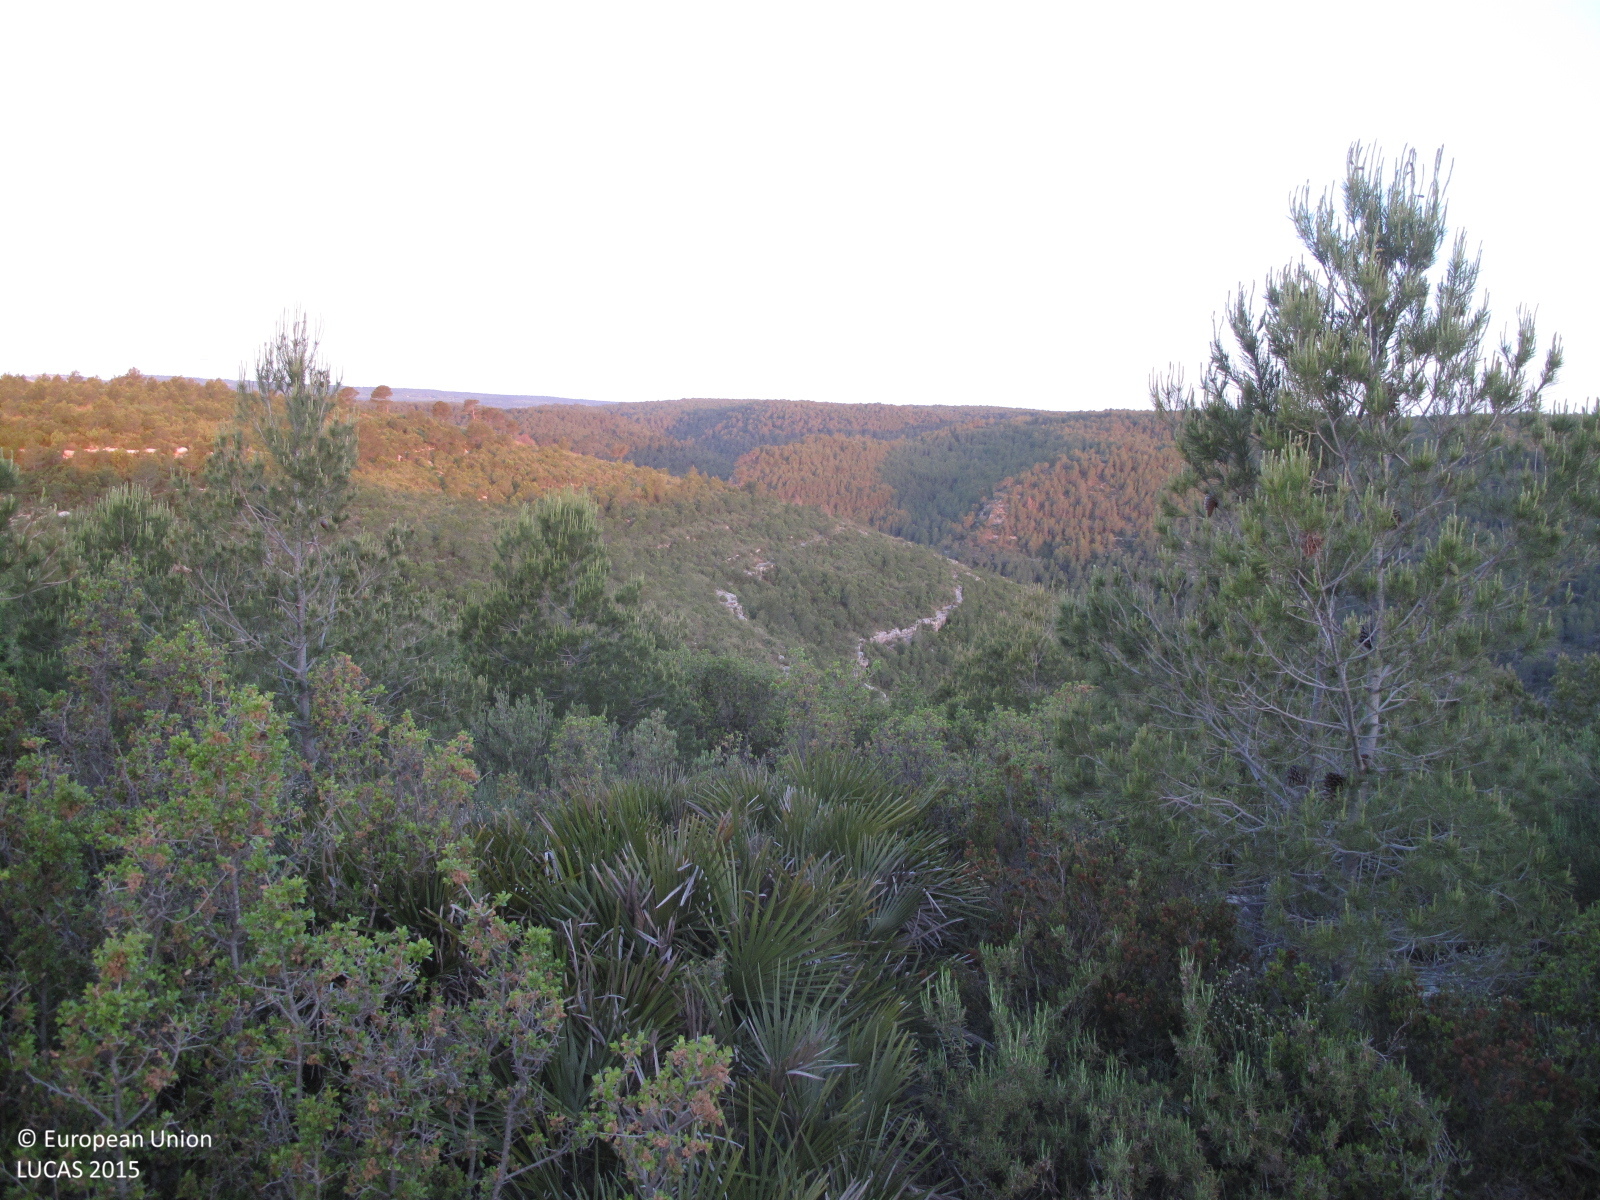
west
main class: Woodland
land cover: Pine dominated coniferous woodland
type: coniferous forest of the mediterranean region
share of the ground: 25 - 50 %
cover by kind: coniferous forest trees 40 %, shrubs 20 %, herbaceous plants 20 %, consolidated bare surface 20 %
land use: Semi-natural and natural areas not in use
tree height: < 5 m
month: May
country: ES
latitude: 39.0491
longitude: -0.7983
